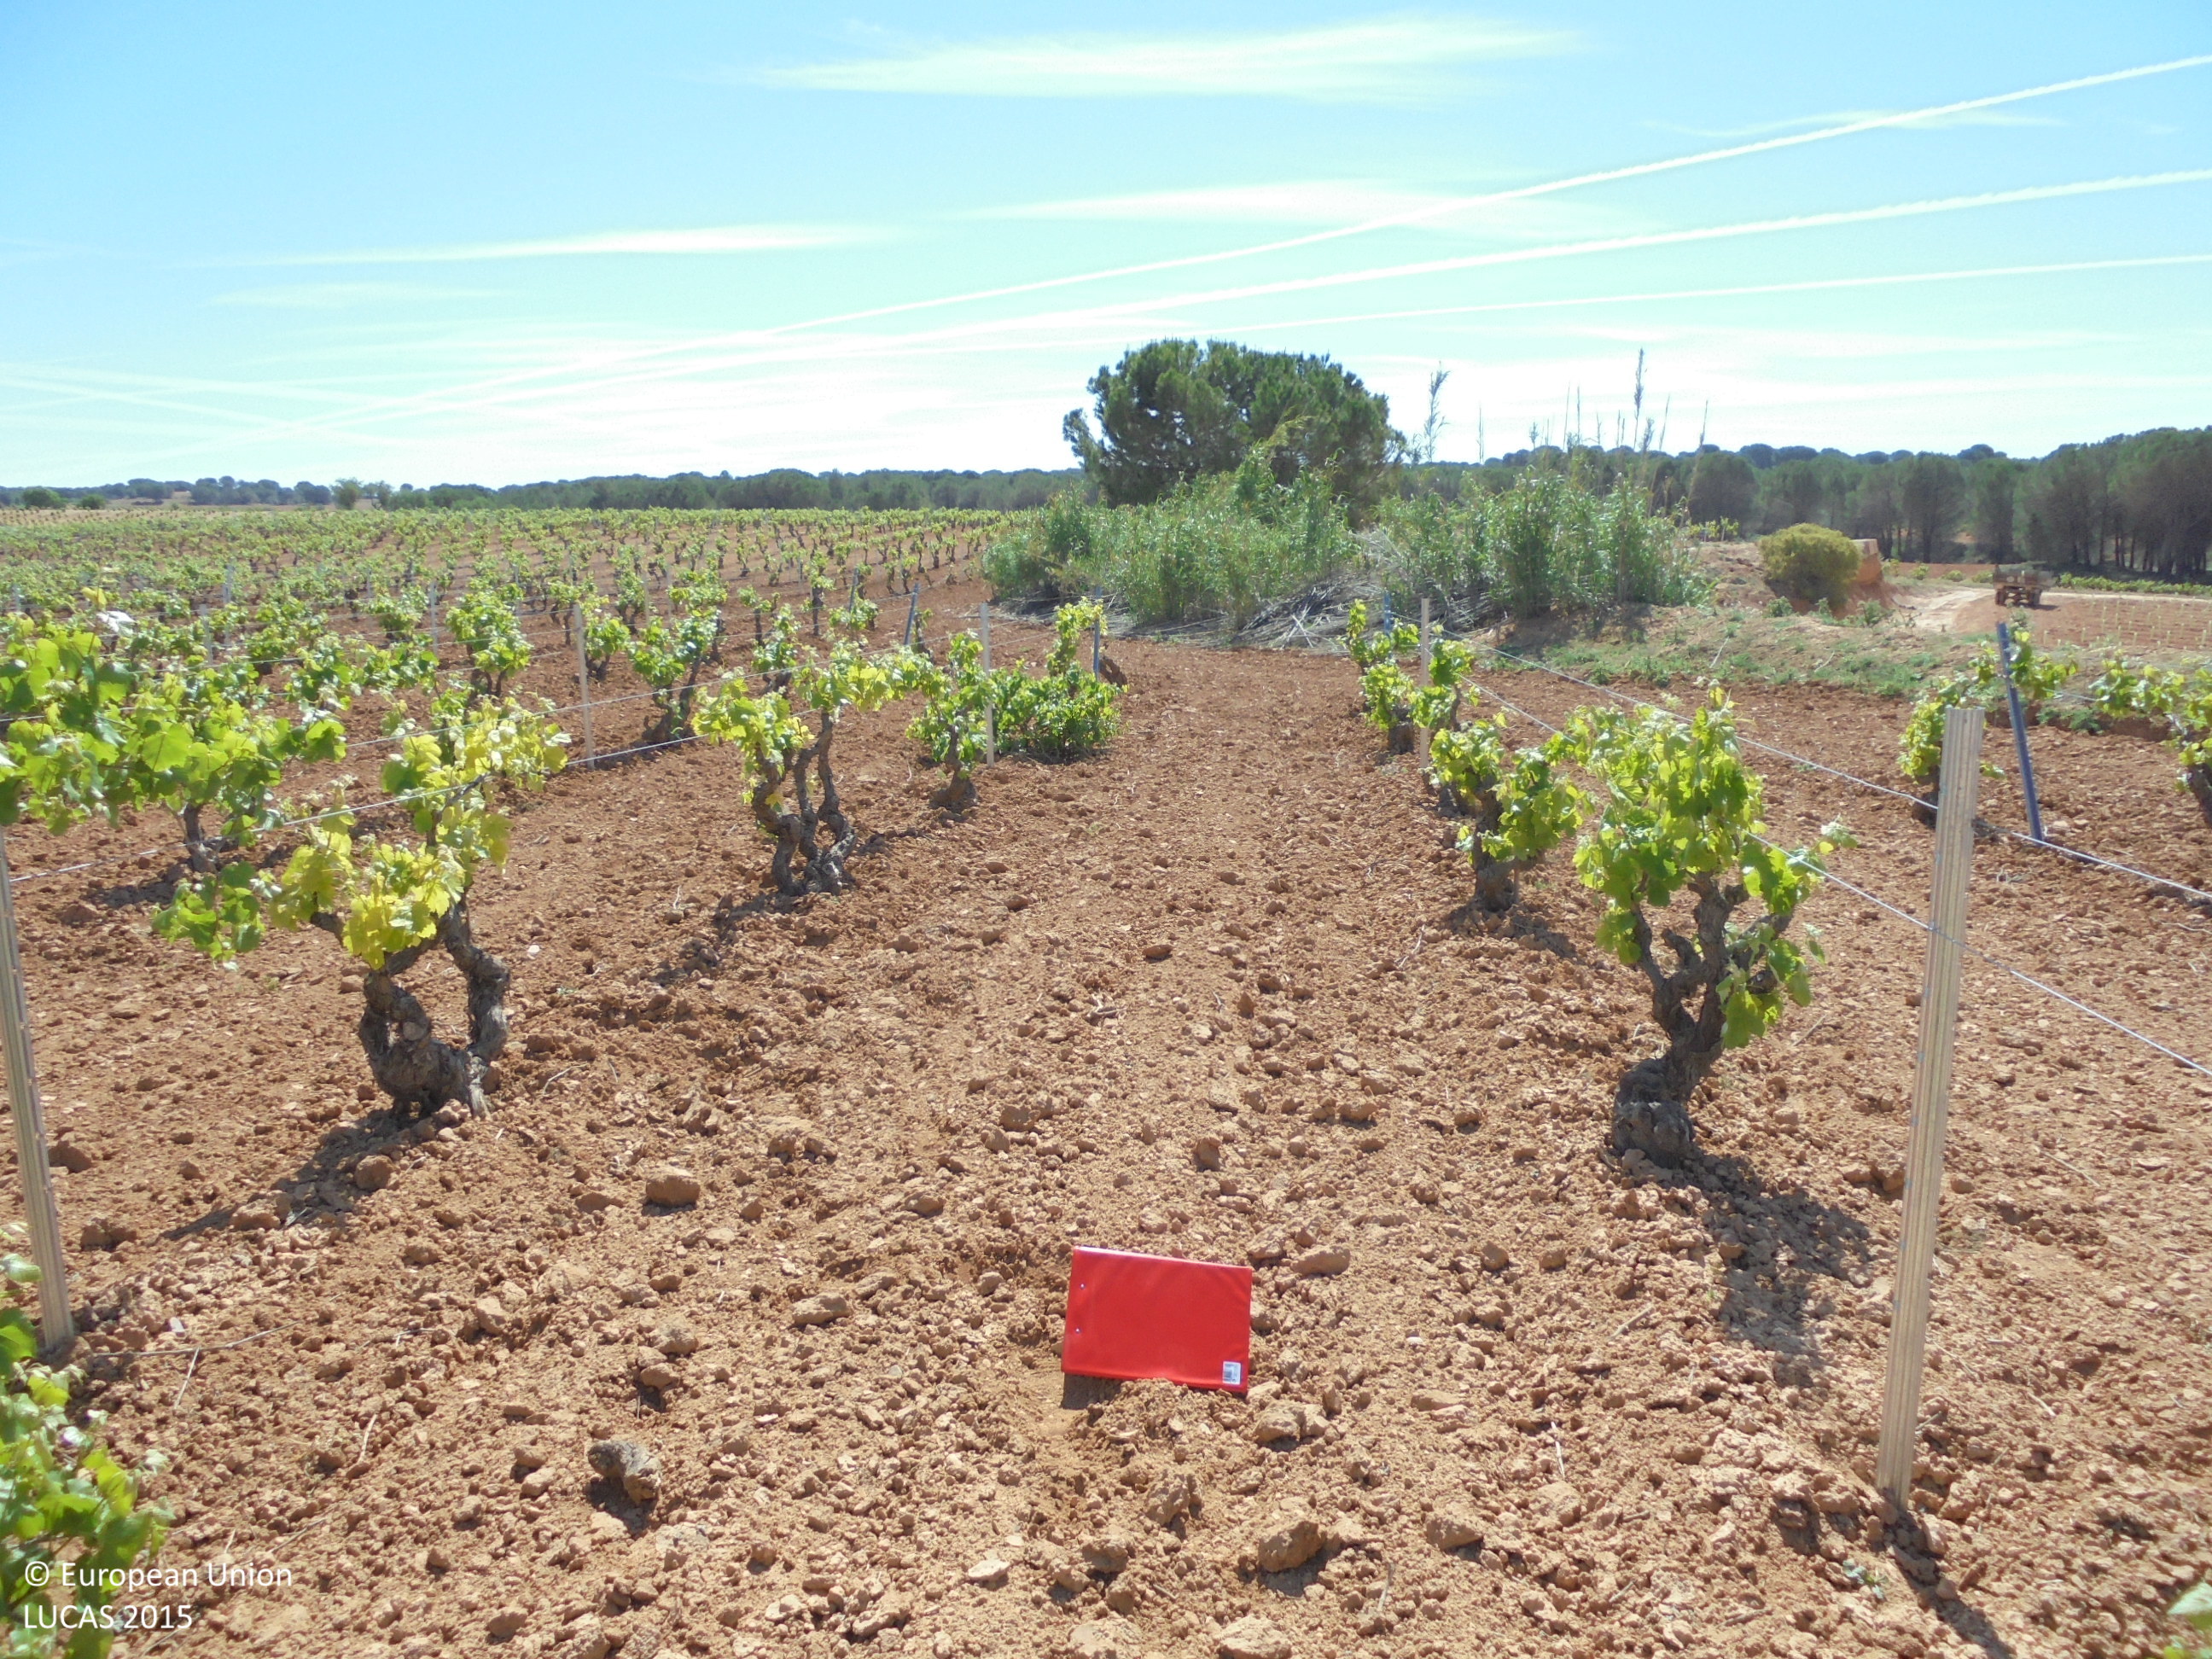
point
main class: Cropland
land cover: Vineyards
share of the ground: 10 - 25 %
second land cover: Other bare soil
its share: > 75 %
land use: Agriculture (excluding fallow land and kitchen gardens)
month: May
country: ES
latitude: 39.3071
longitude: -1.5644
